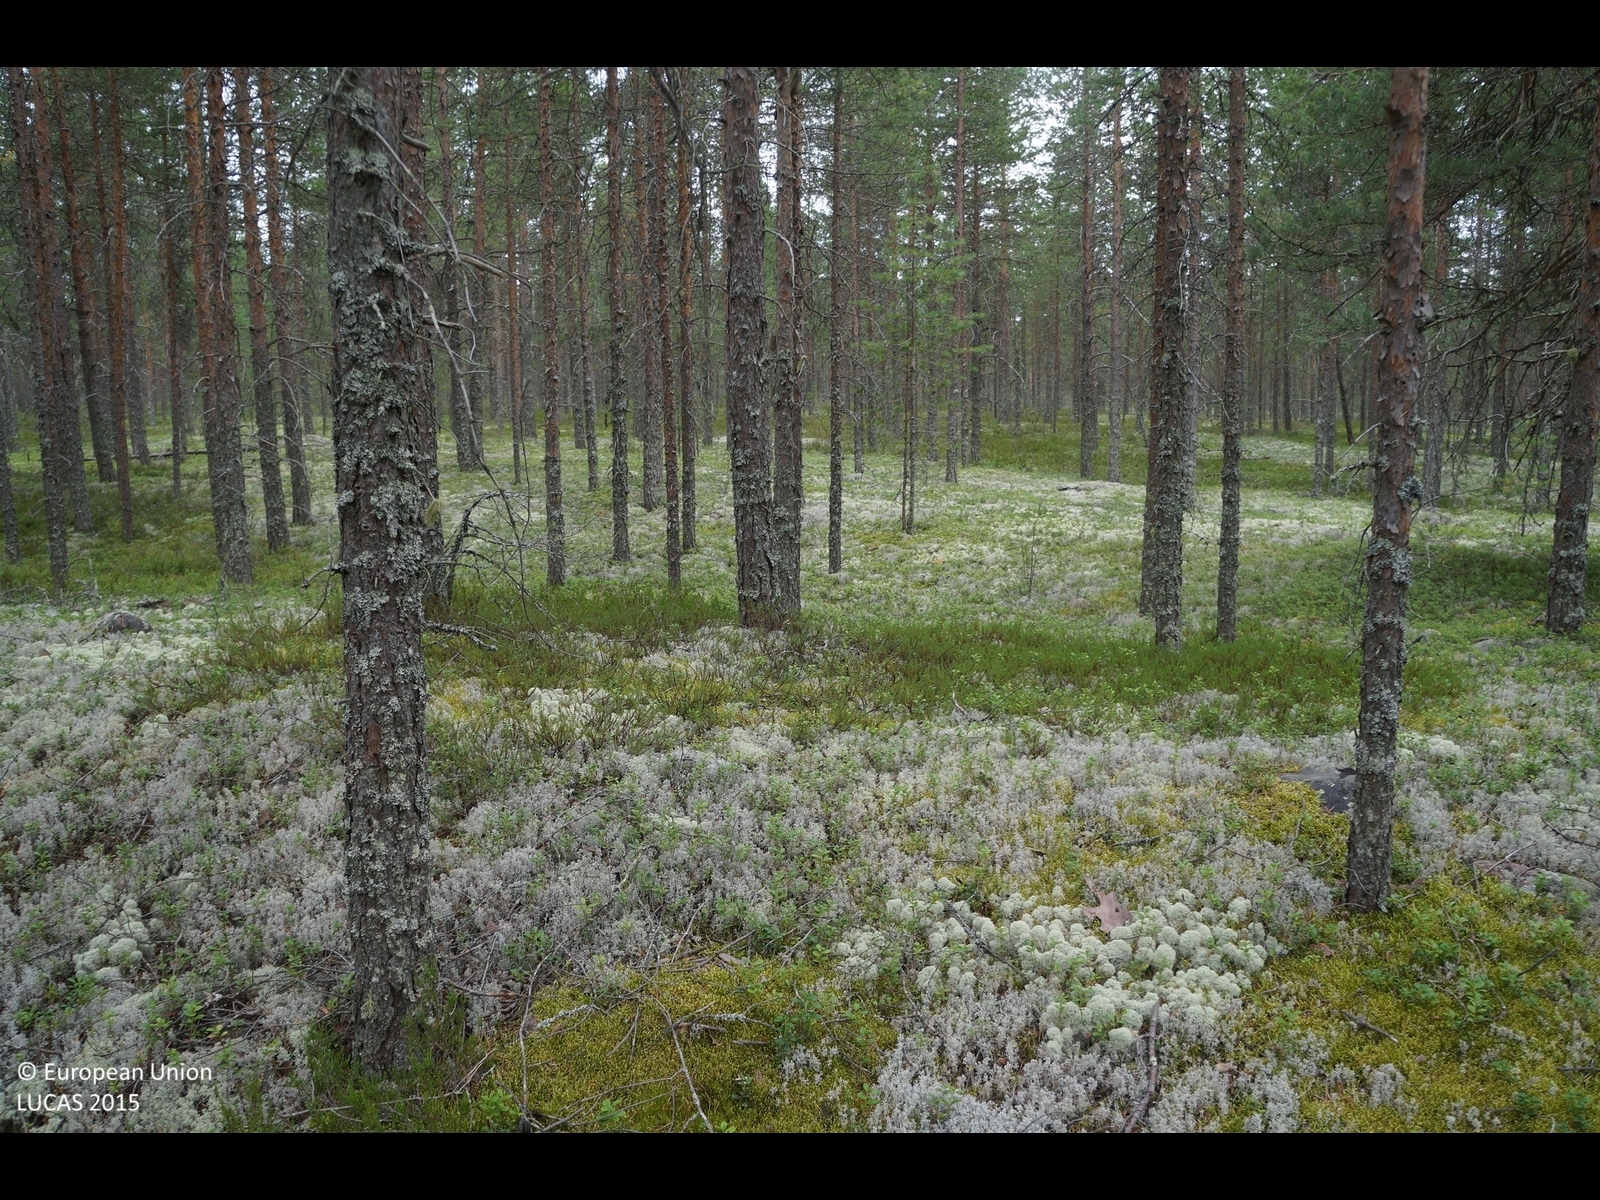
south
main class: Woodland
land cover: Pine dominated coniferous woodland
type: boreal forest
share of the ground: 50 - 75 %
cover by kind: coniferous forest trees 50 %, lichens and mosses 35 %, shrubs 15 %
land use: Forestry
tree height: > 5 m
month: August
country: FI
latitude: 64.8131
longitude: 24.9209
